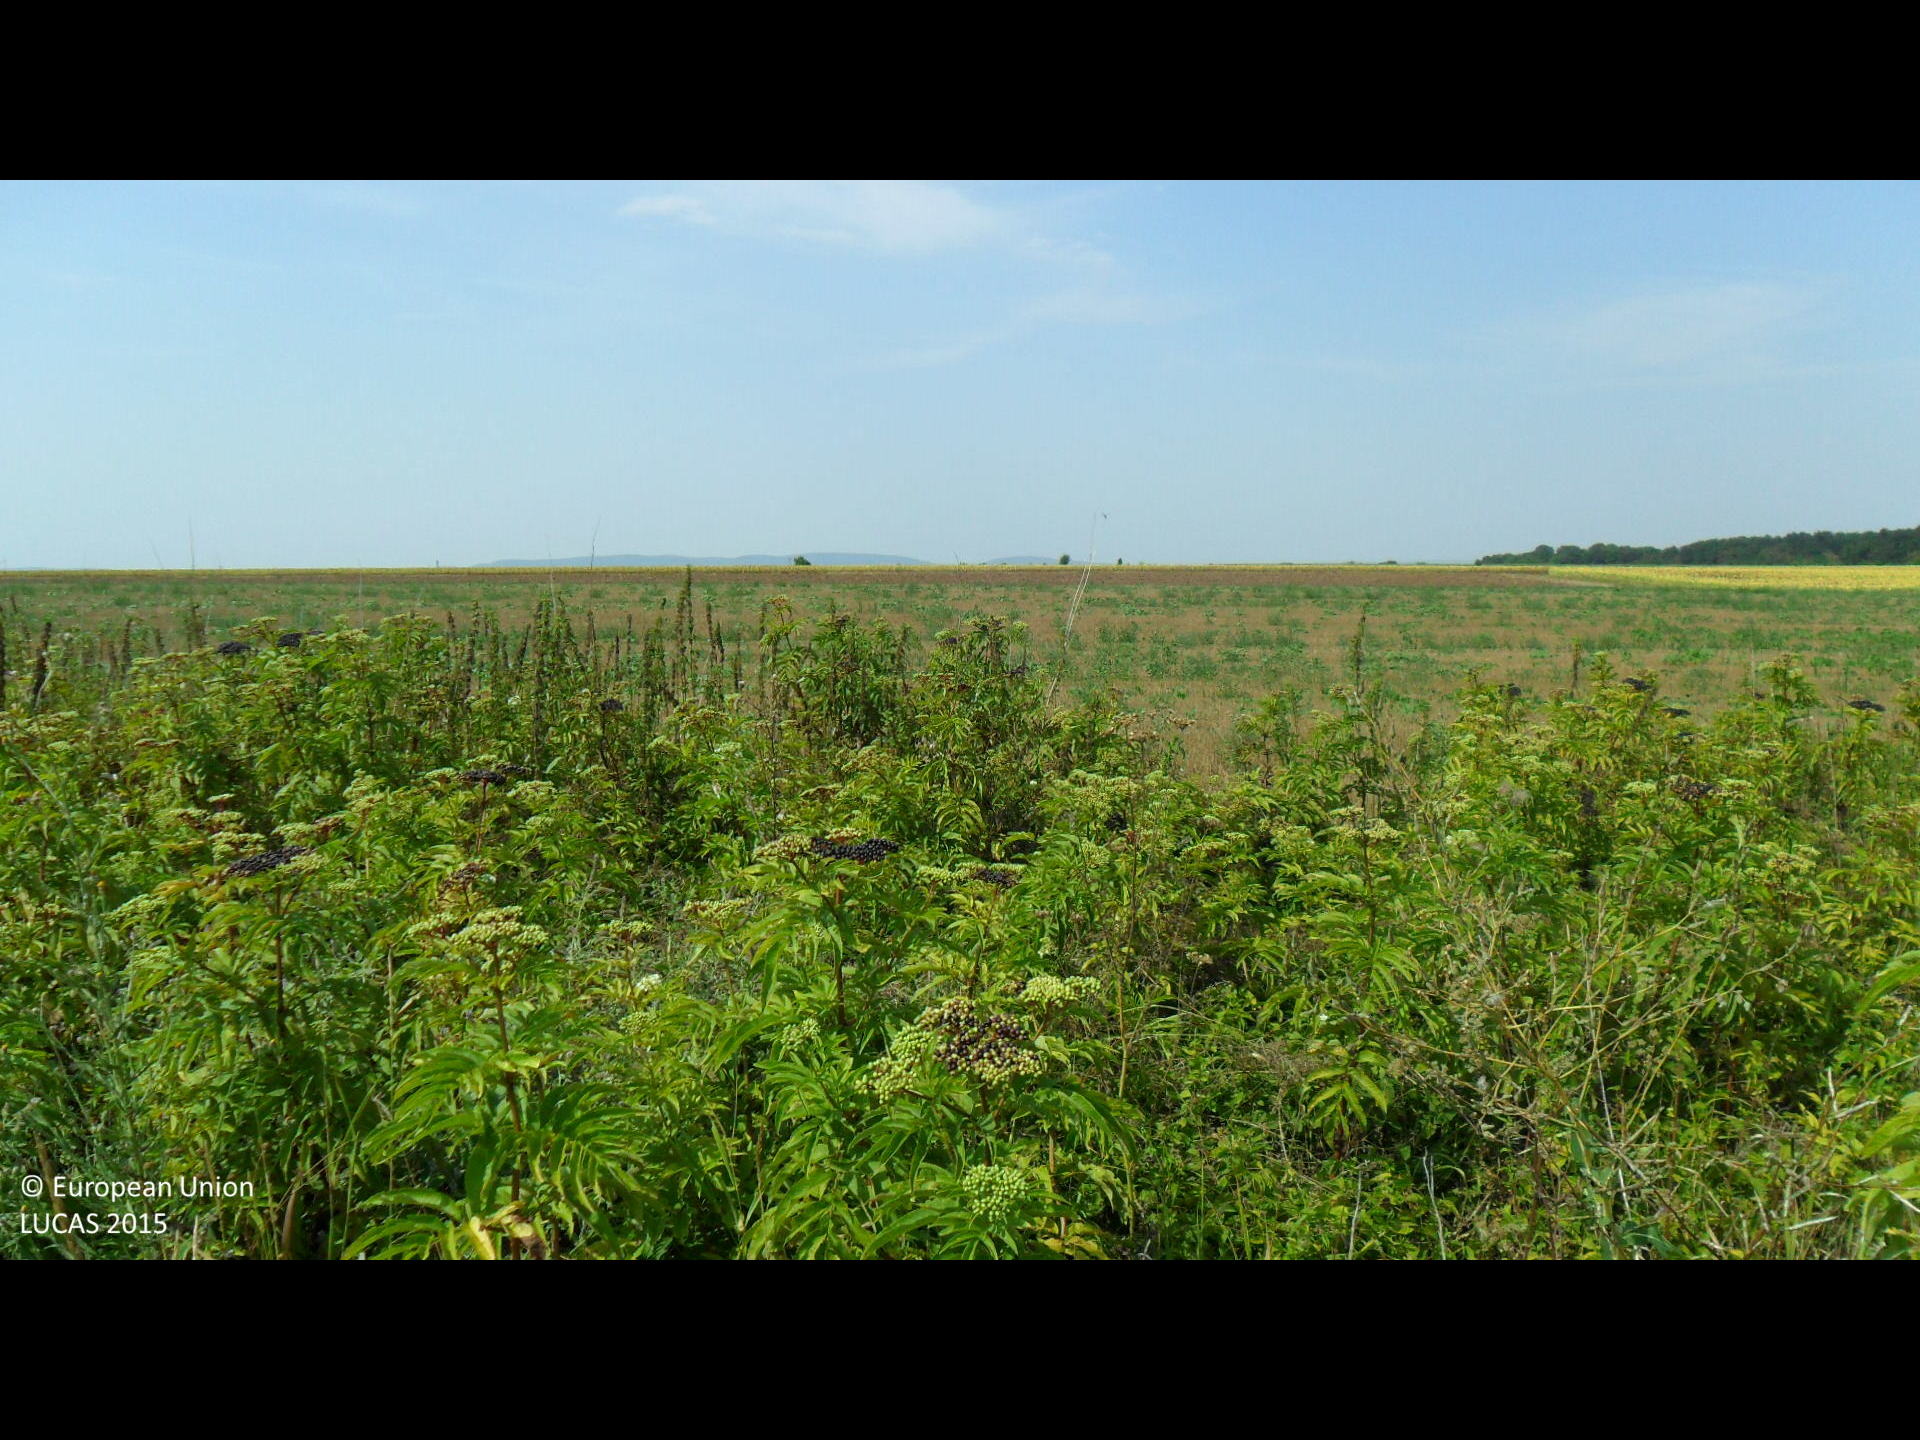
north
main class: Grassland
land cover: Spontaneously vegetated surfaces
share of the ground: > 75 %
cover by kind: herbaceous plants 100 %
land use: Semi-natural and natural areas not in use
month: August
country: BG
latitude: 43.3147
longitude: 26.2611
